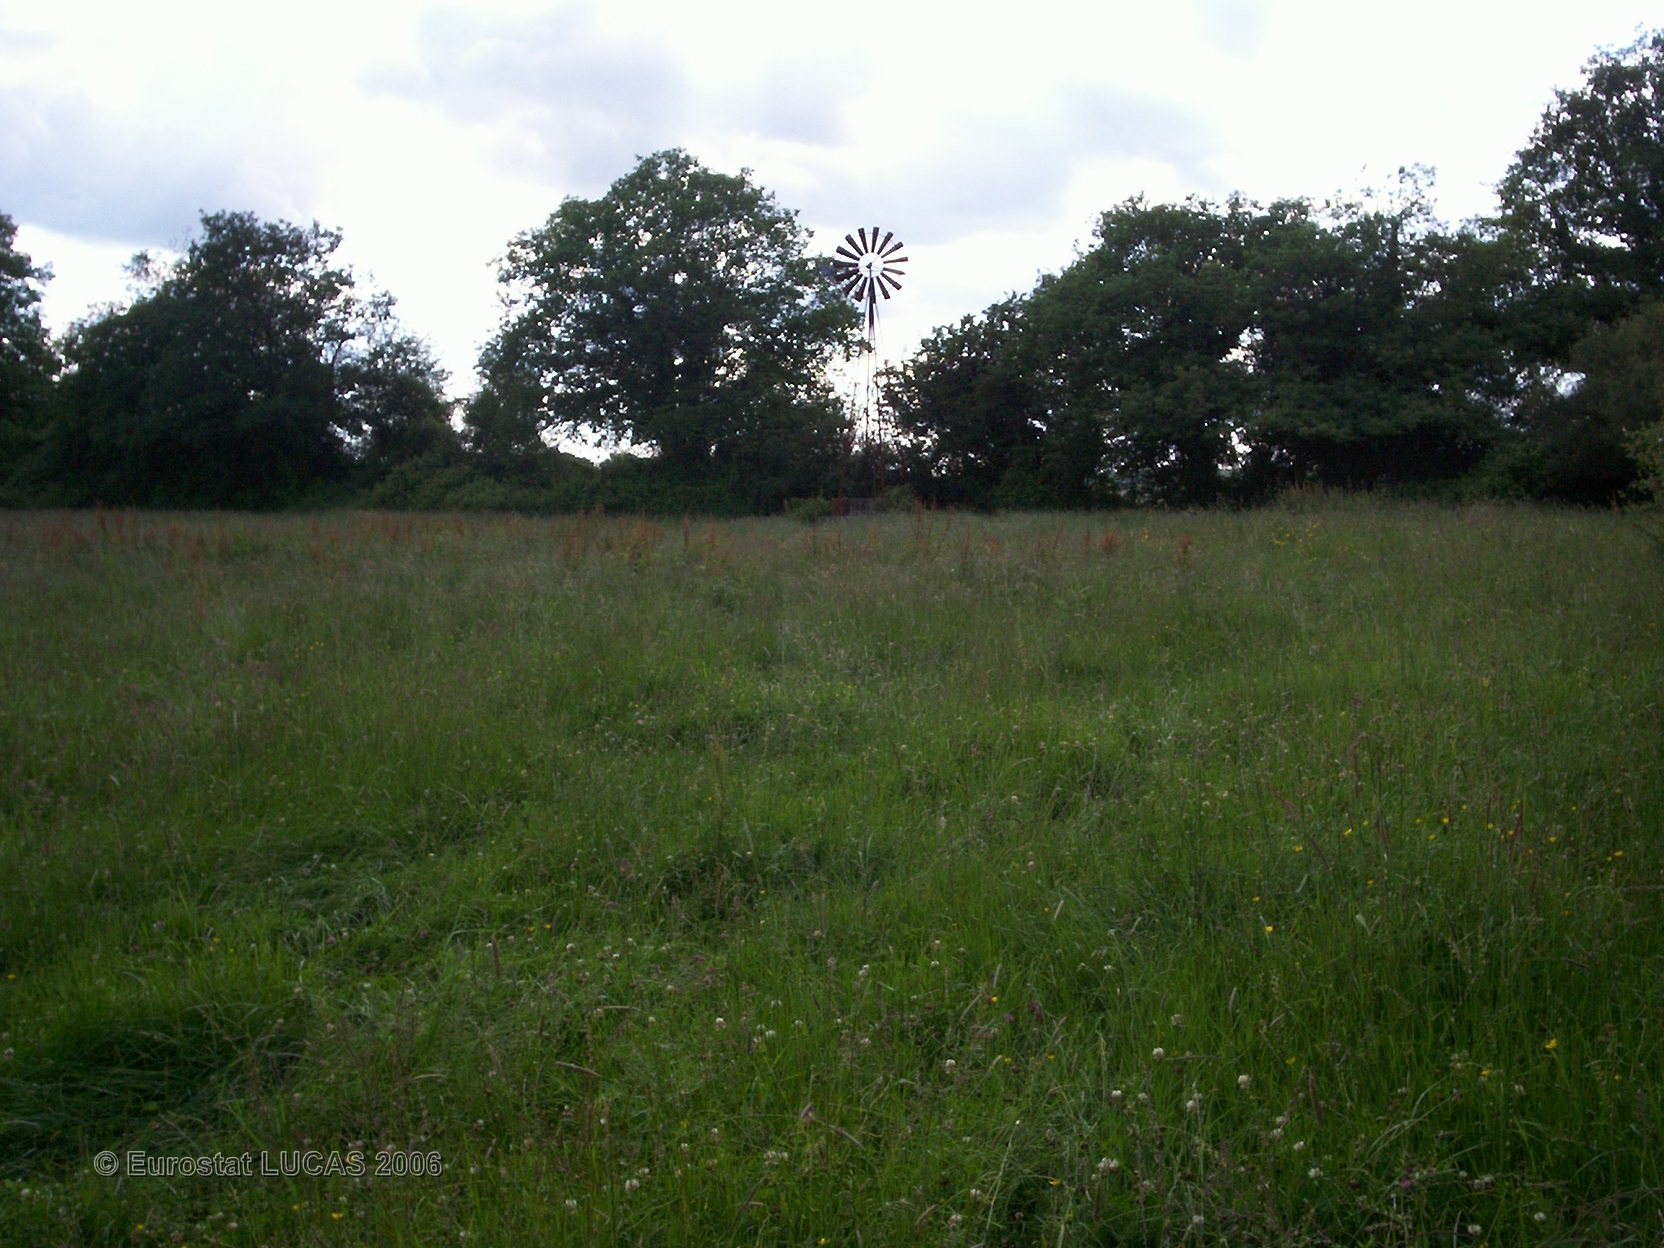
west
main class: Grassland
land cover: Grassland without tree/shrub cover
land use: Agriculture (excluding fallow land and kitchen gardens)
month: June
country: FR
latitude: 47.0439
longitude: 3.0066
